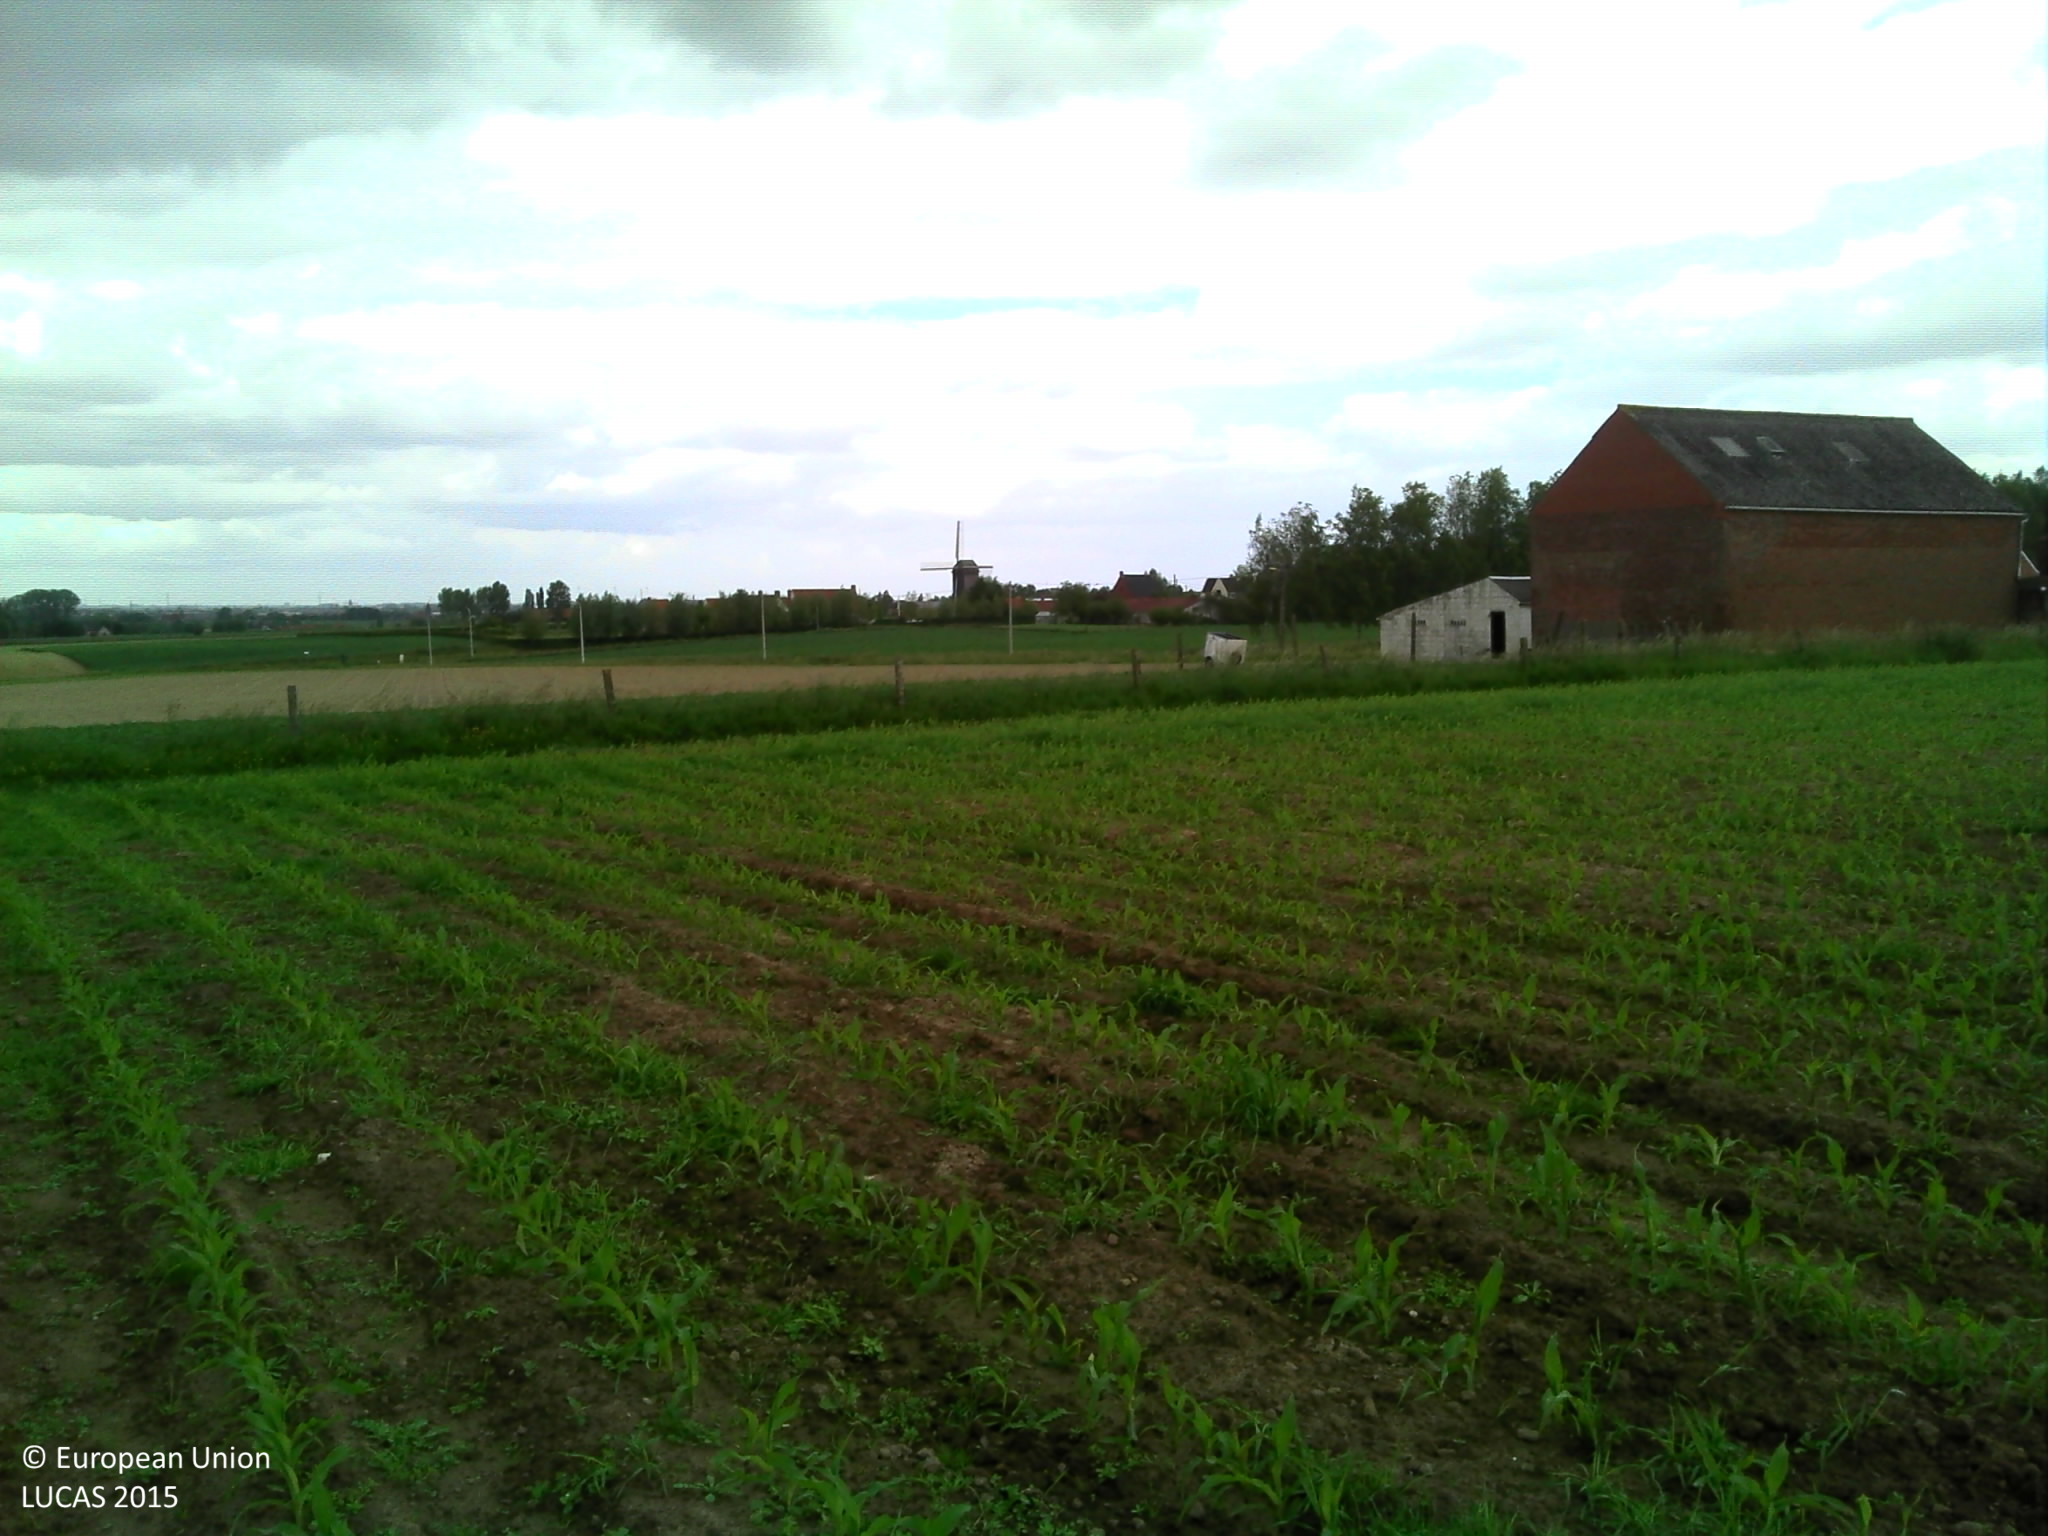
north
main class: Cropland
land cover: Maize
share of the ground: < 10 %
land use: Agriculture (excluding fallow land and kitchen gardens)
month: June
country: BE
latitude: 50.8256
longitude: 3.4474
